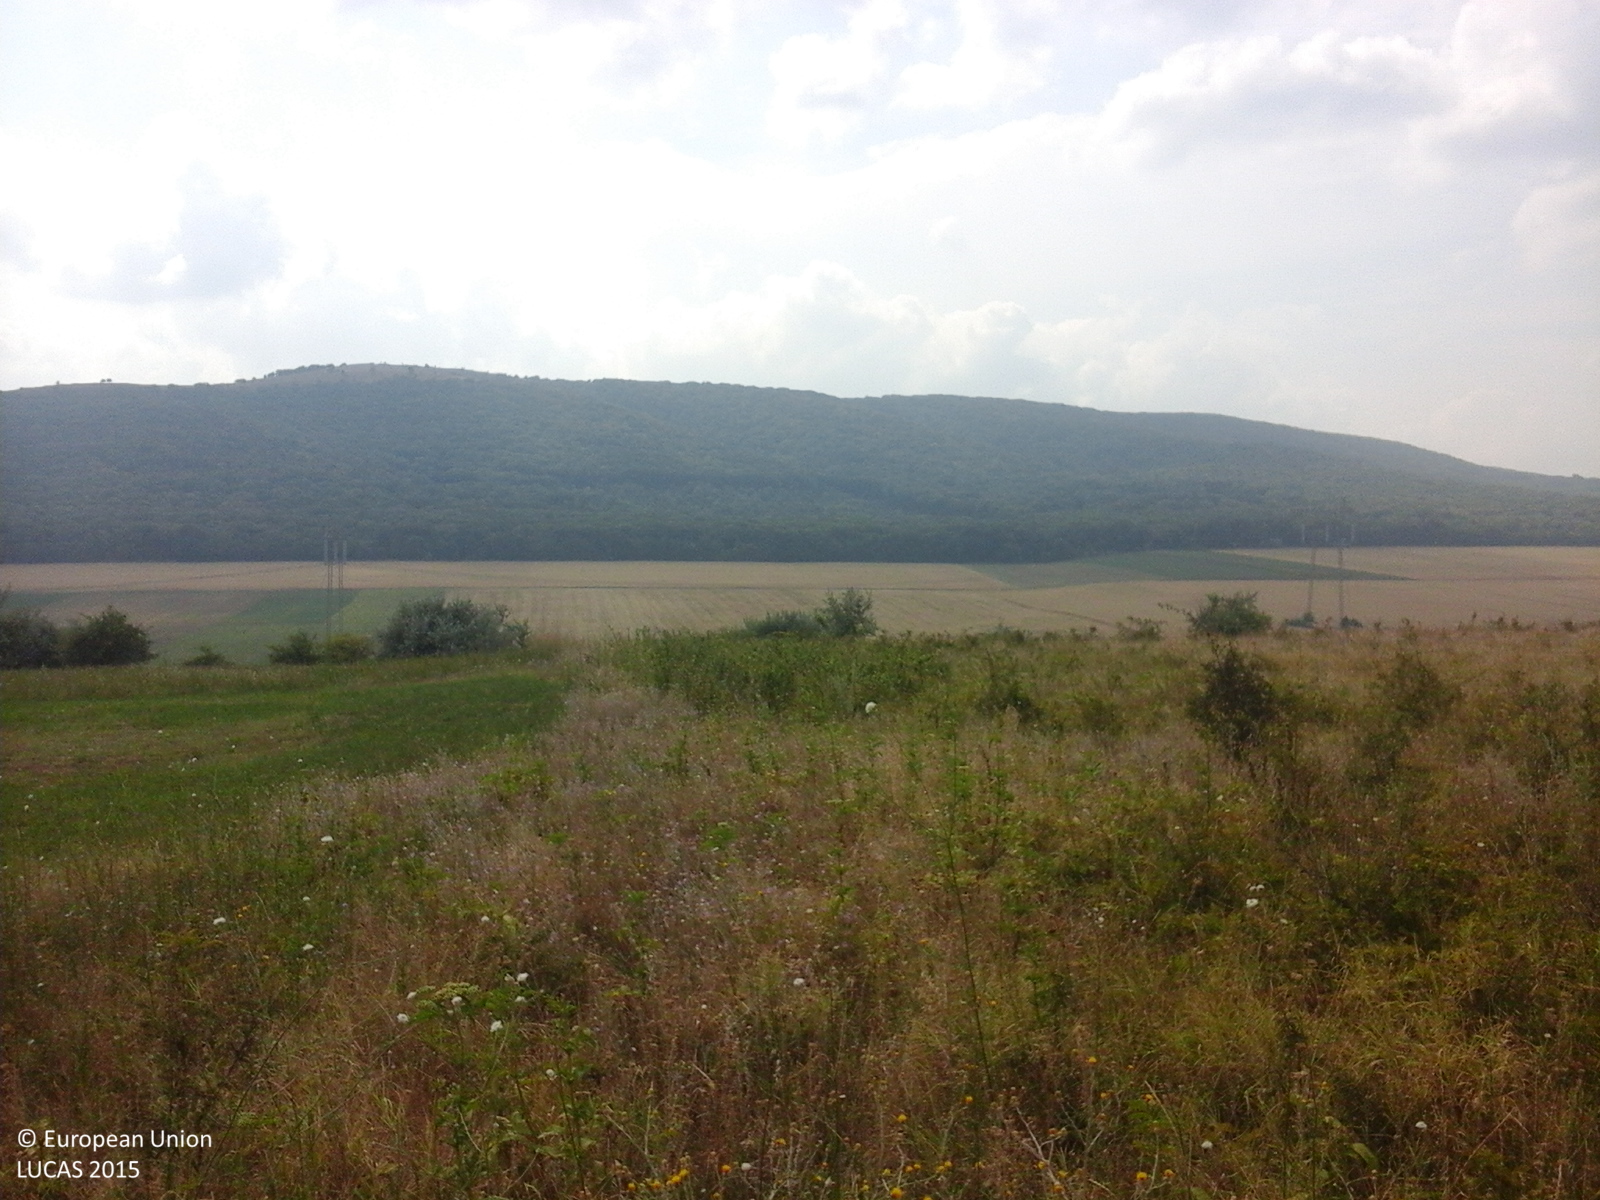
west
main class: Grassland
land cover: Spontaneously vegetated surfaces
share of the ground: > 75 %
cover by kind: herbaceous plants 100 %
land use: Agriculture (excluding fallow land and kitchen gardens)
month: July
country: RO
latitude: 45.1119
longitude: 28.4705
